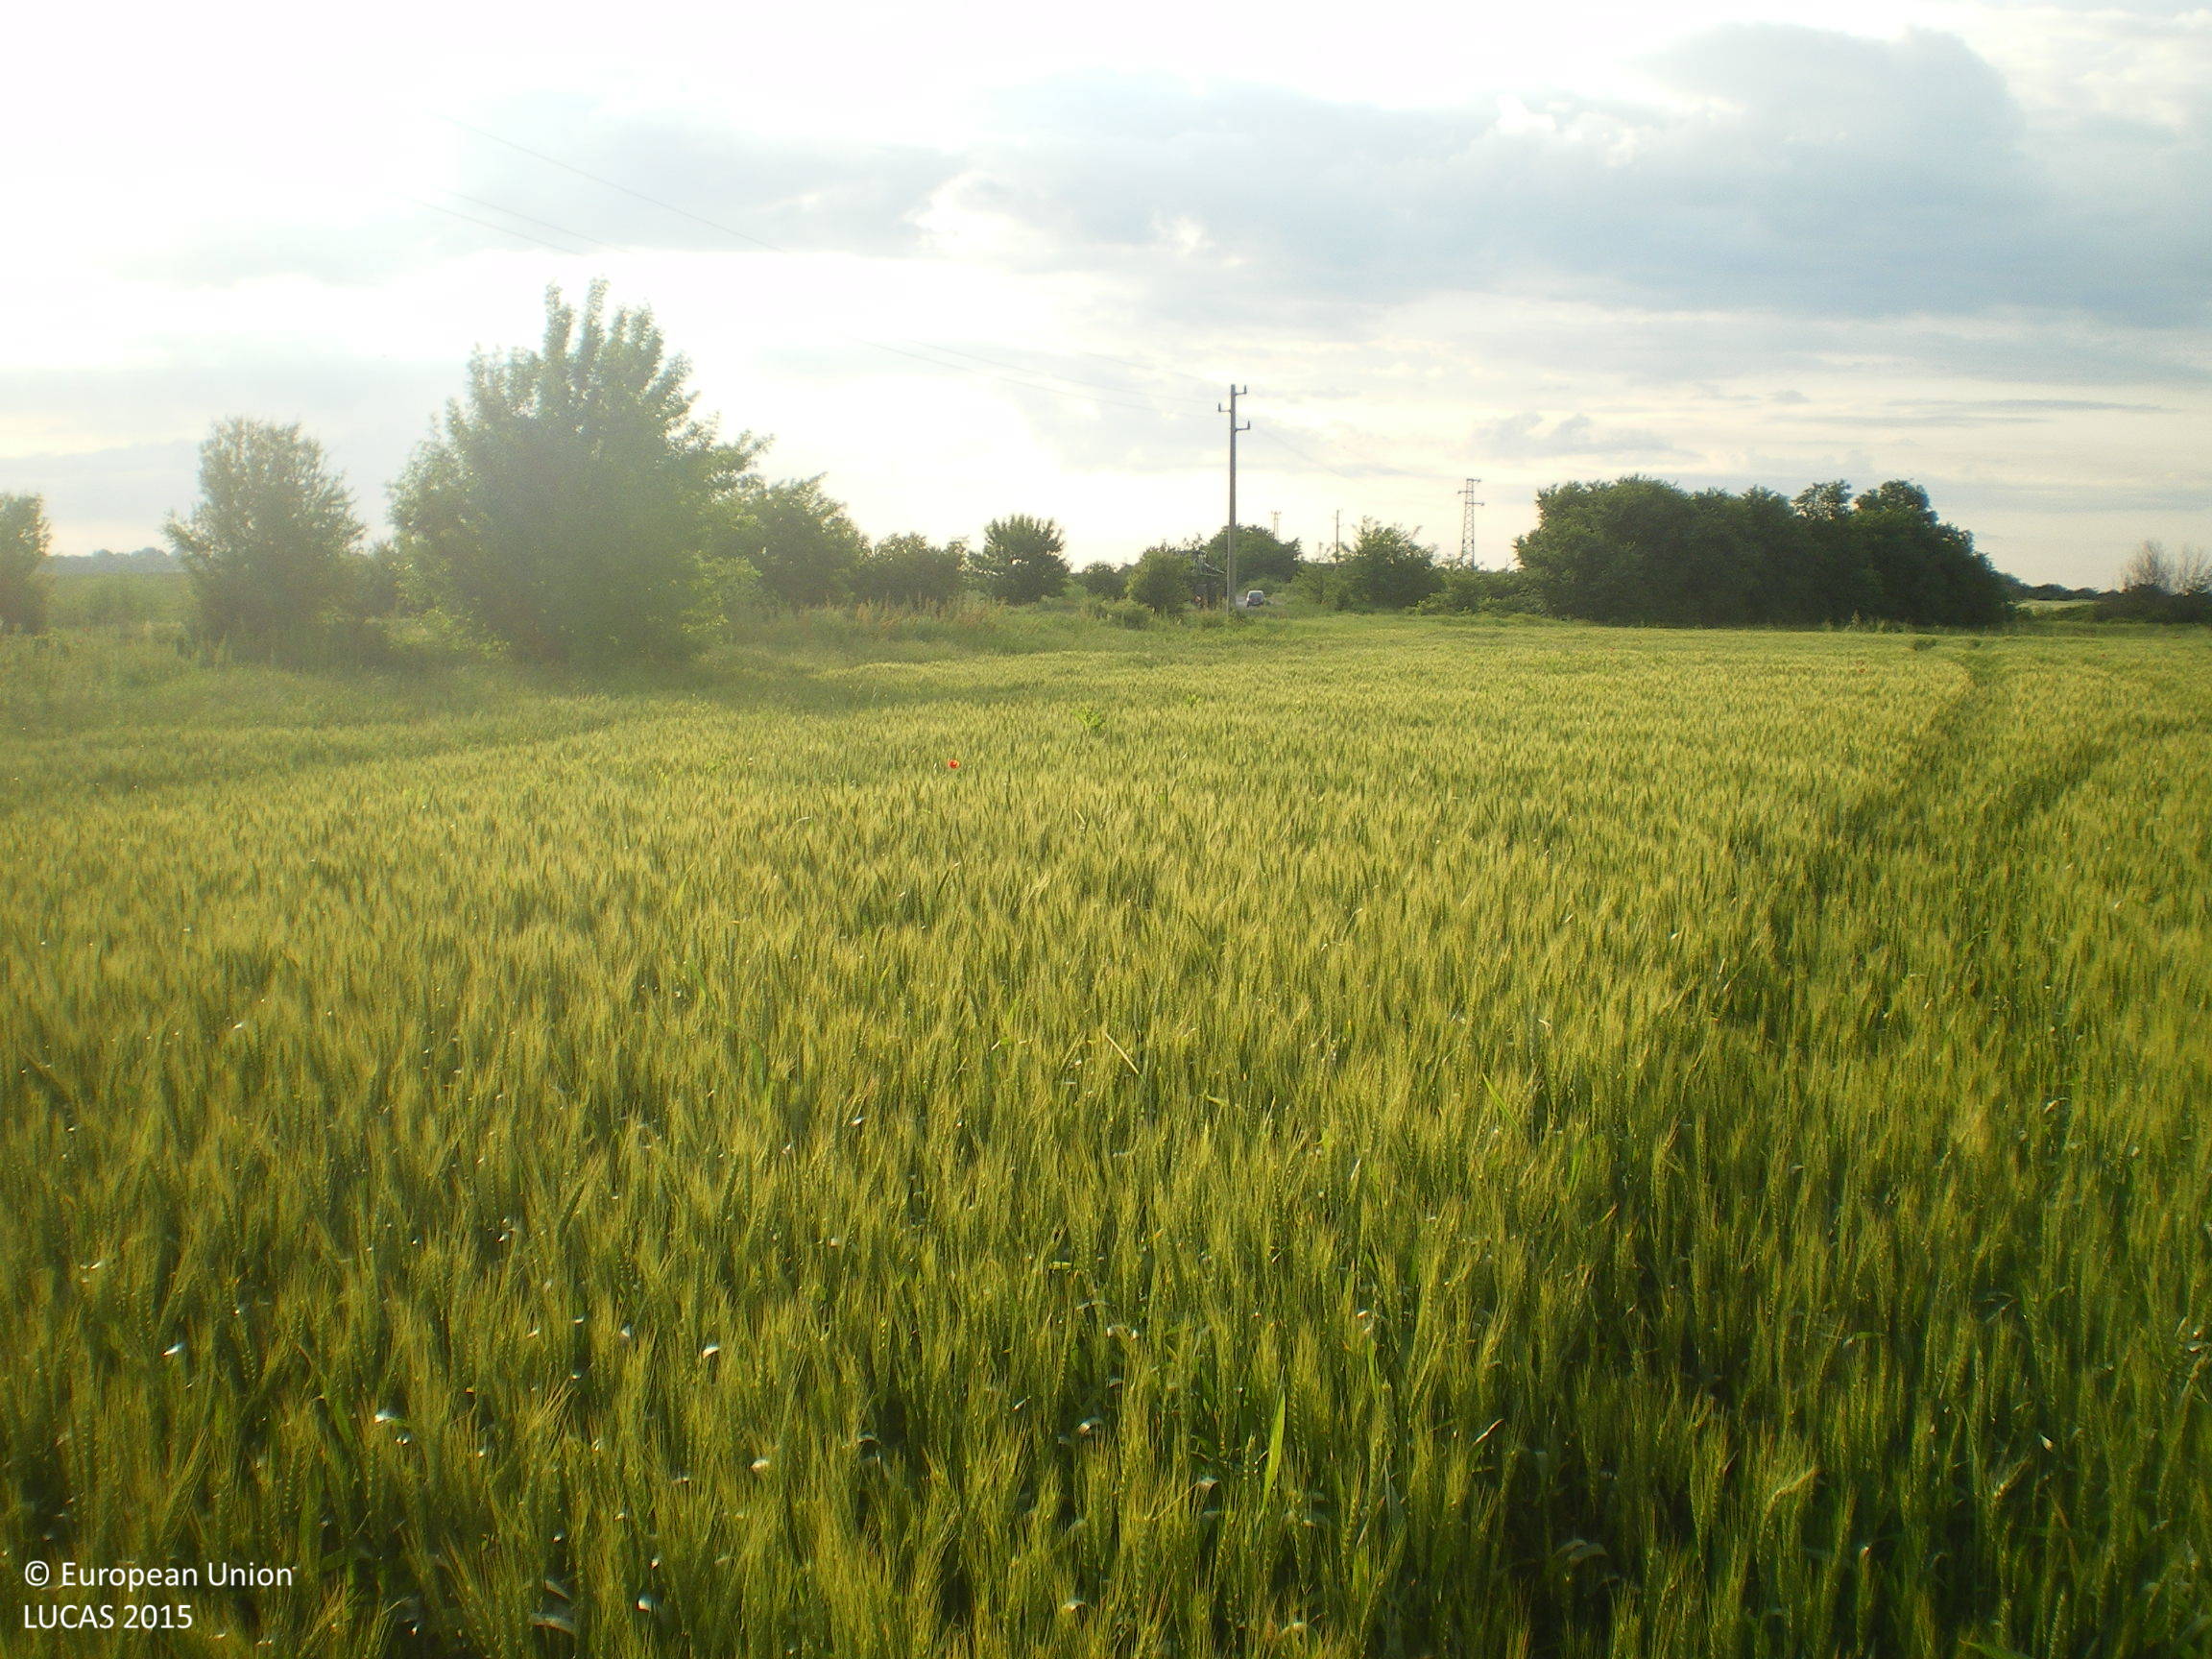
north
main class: Cropland
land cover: Common wheat
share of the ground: > 75 %
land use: Agriculture (excluding fallow land and kitchen gardens)
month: May
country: BG
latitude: 42.1971
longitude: 25.4330
